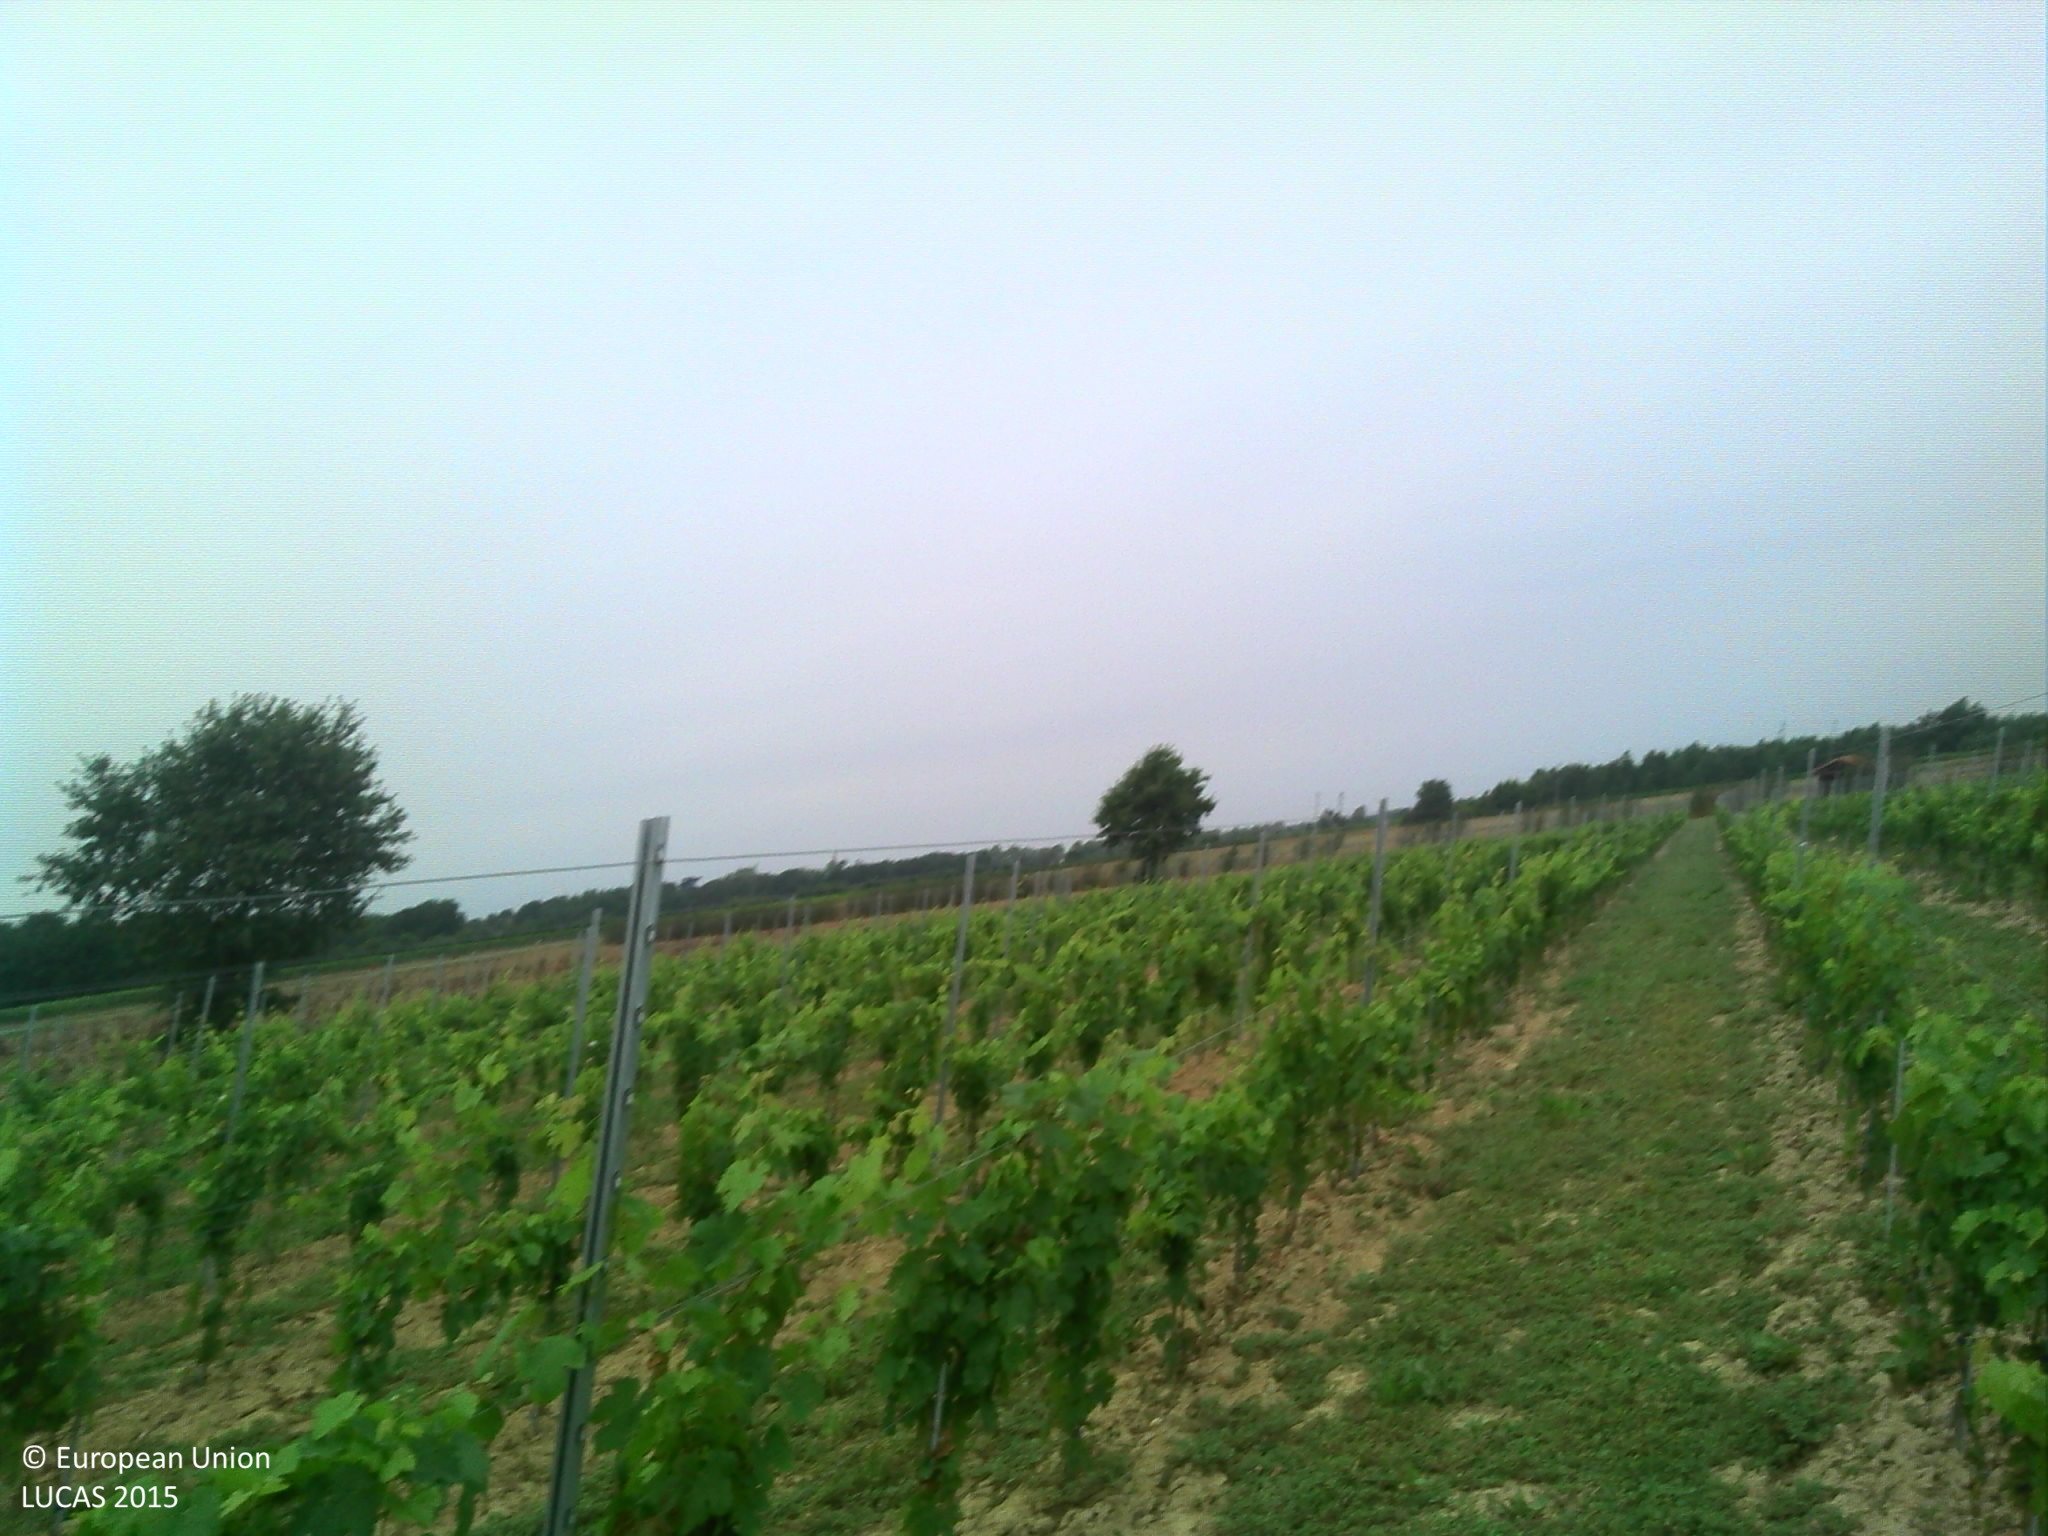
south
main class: Cropland
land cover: Vineyards
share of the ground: 25 - 50 %
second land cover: Spontaneously vegetated surfaces
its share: > 75 %
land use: Agriculture (excluding fallow land and kitchen gardens)
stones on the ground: < 10 %
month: August
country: FR
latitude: 43.8980
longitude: 1.3481
